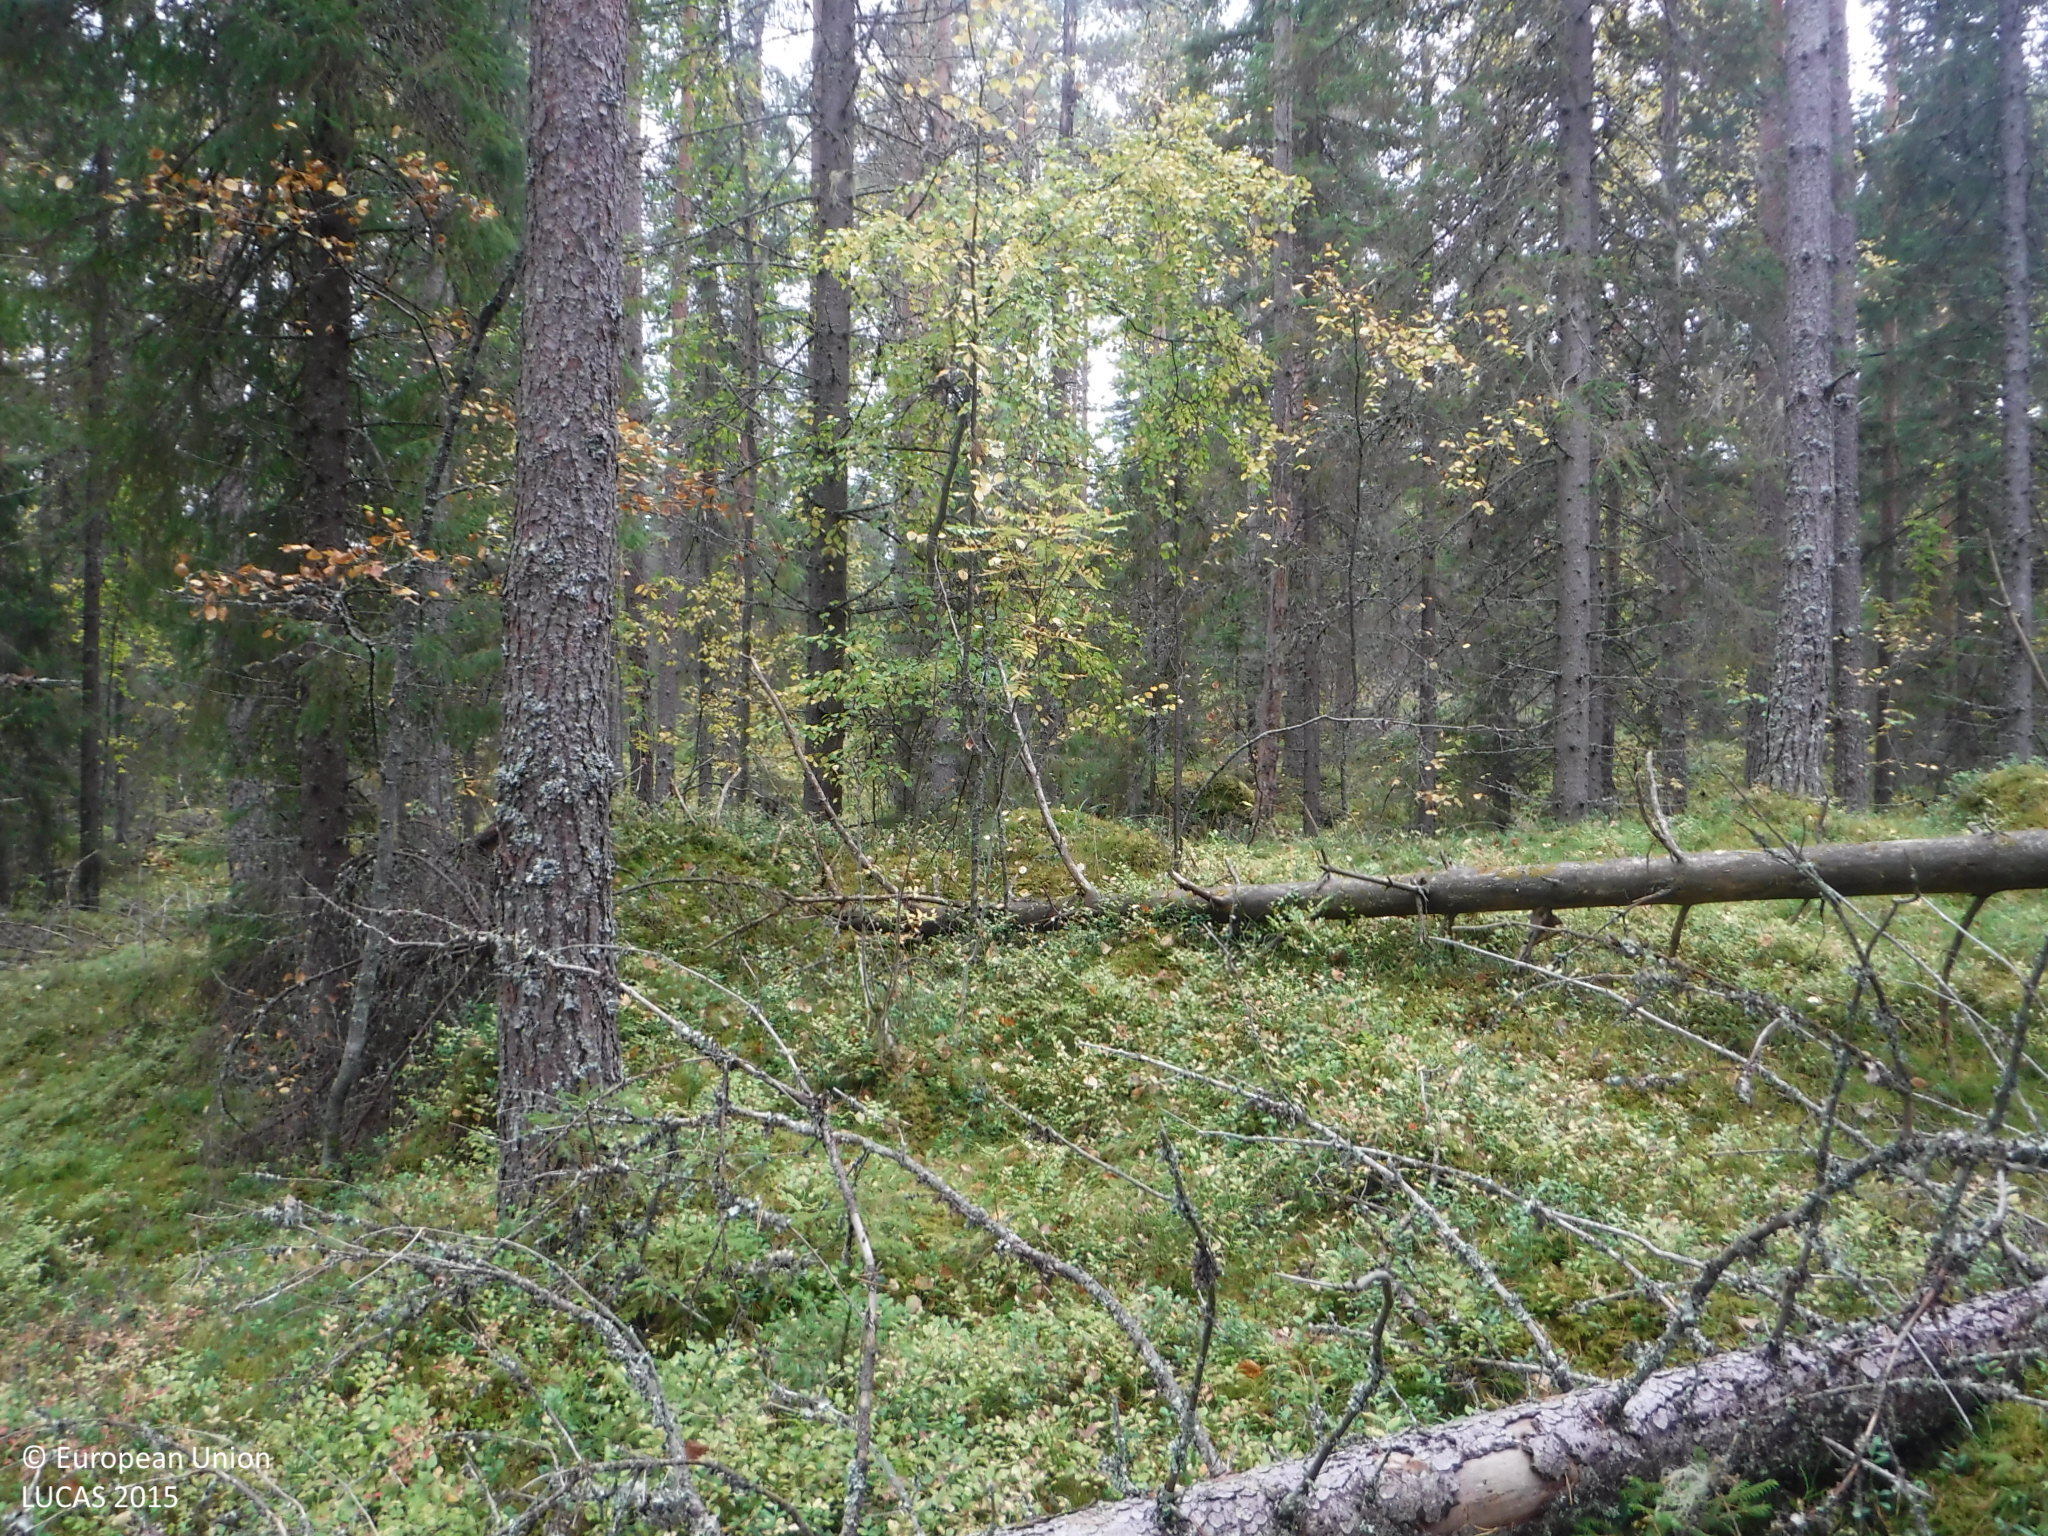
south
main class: Woodland
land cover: Other coniferous woodland
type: boreal forest
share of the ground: 50 - 75 %
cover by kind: coniferous forest trees 45 %, shrubs 25 %, lichens and mosses 25 %, broadleaved forest trees 5 %
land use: Forestry
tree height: > 5 m
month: September
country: FI
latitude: 61.7509
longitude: 24.2002
